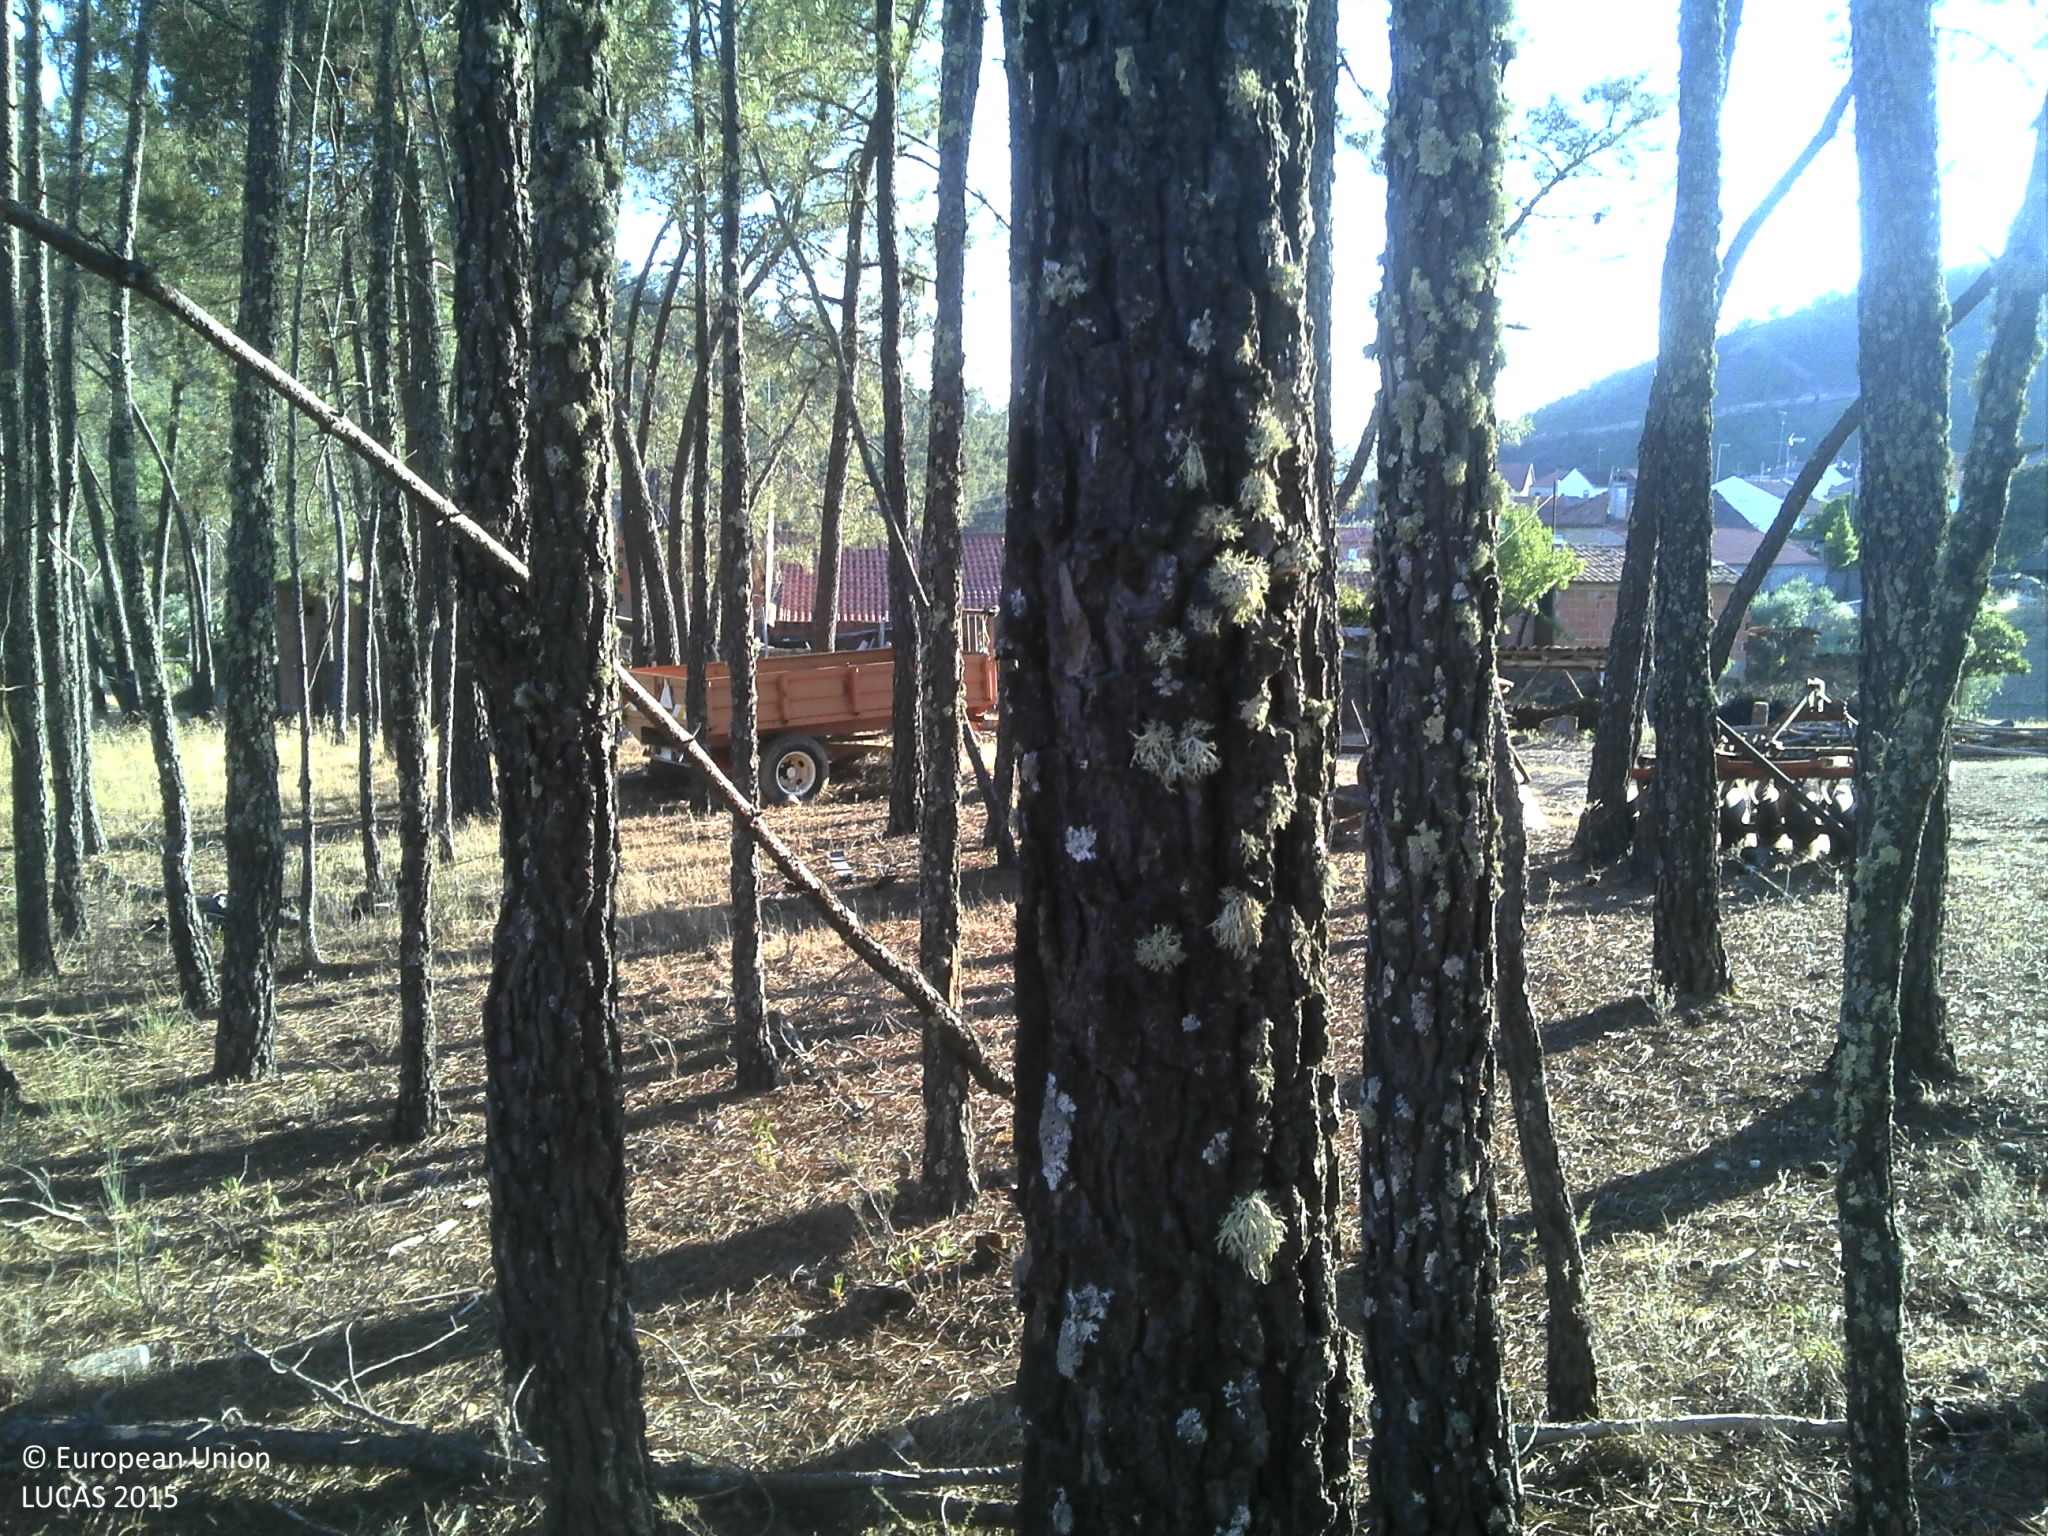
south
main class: Woodland
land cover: Pine dominated coniferous woodland
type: coniferous forest of the mediterranean region
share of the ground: 50 - 75 %
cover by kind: coniferous forest trees 70 %, unconsolidated bare surface 20 %, shrubs 5 %, herbaceous plants 5 %
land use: Forestry
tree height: > 5 m
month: July
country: PT
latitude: 39.9363
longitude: -7.5987
